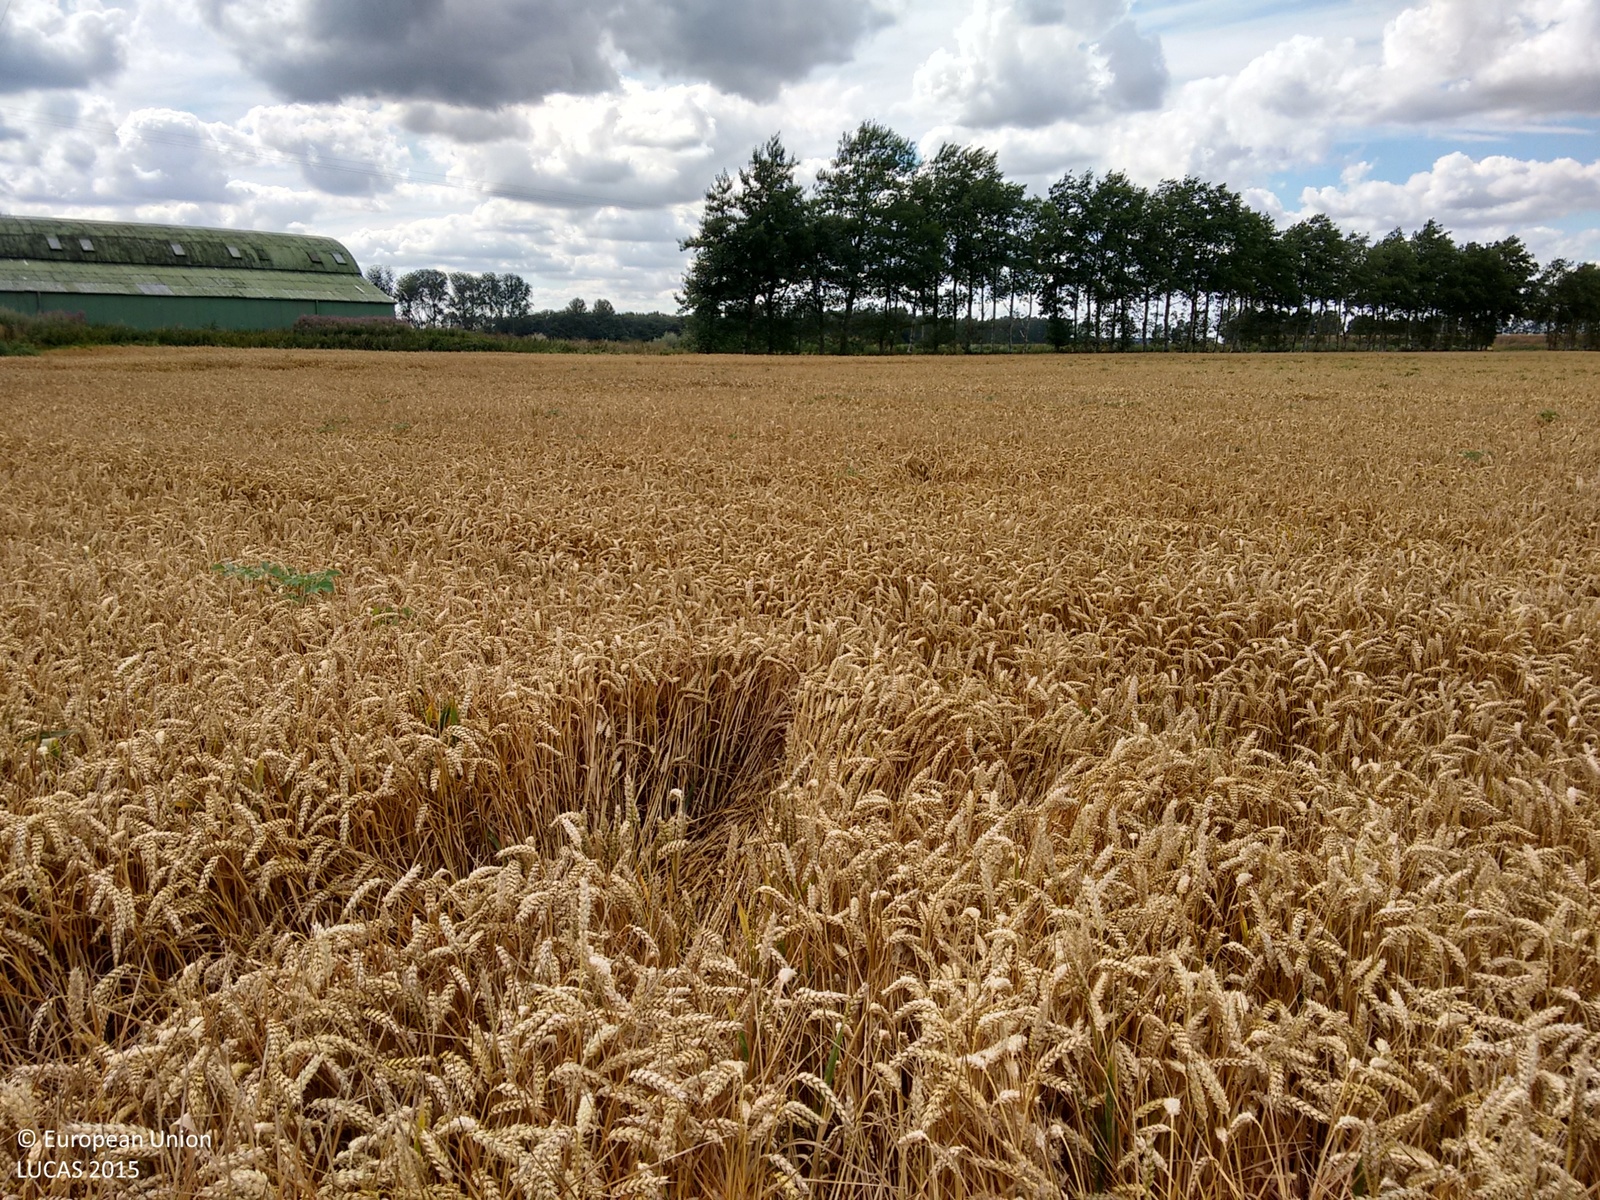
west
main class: Cropland
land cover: Common wheat
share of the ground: > 75 %
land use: Agriculture (excluding fallow land and kitchen gardens)
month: August
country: GB
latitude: 52.4802
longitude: 0.4454
